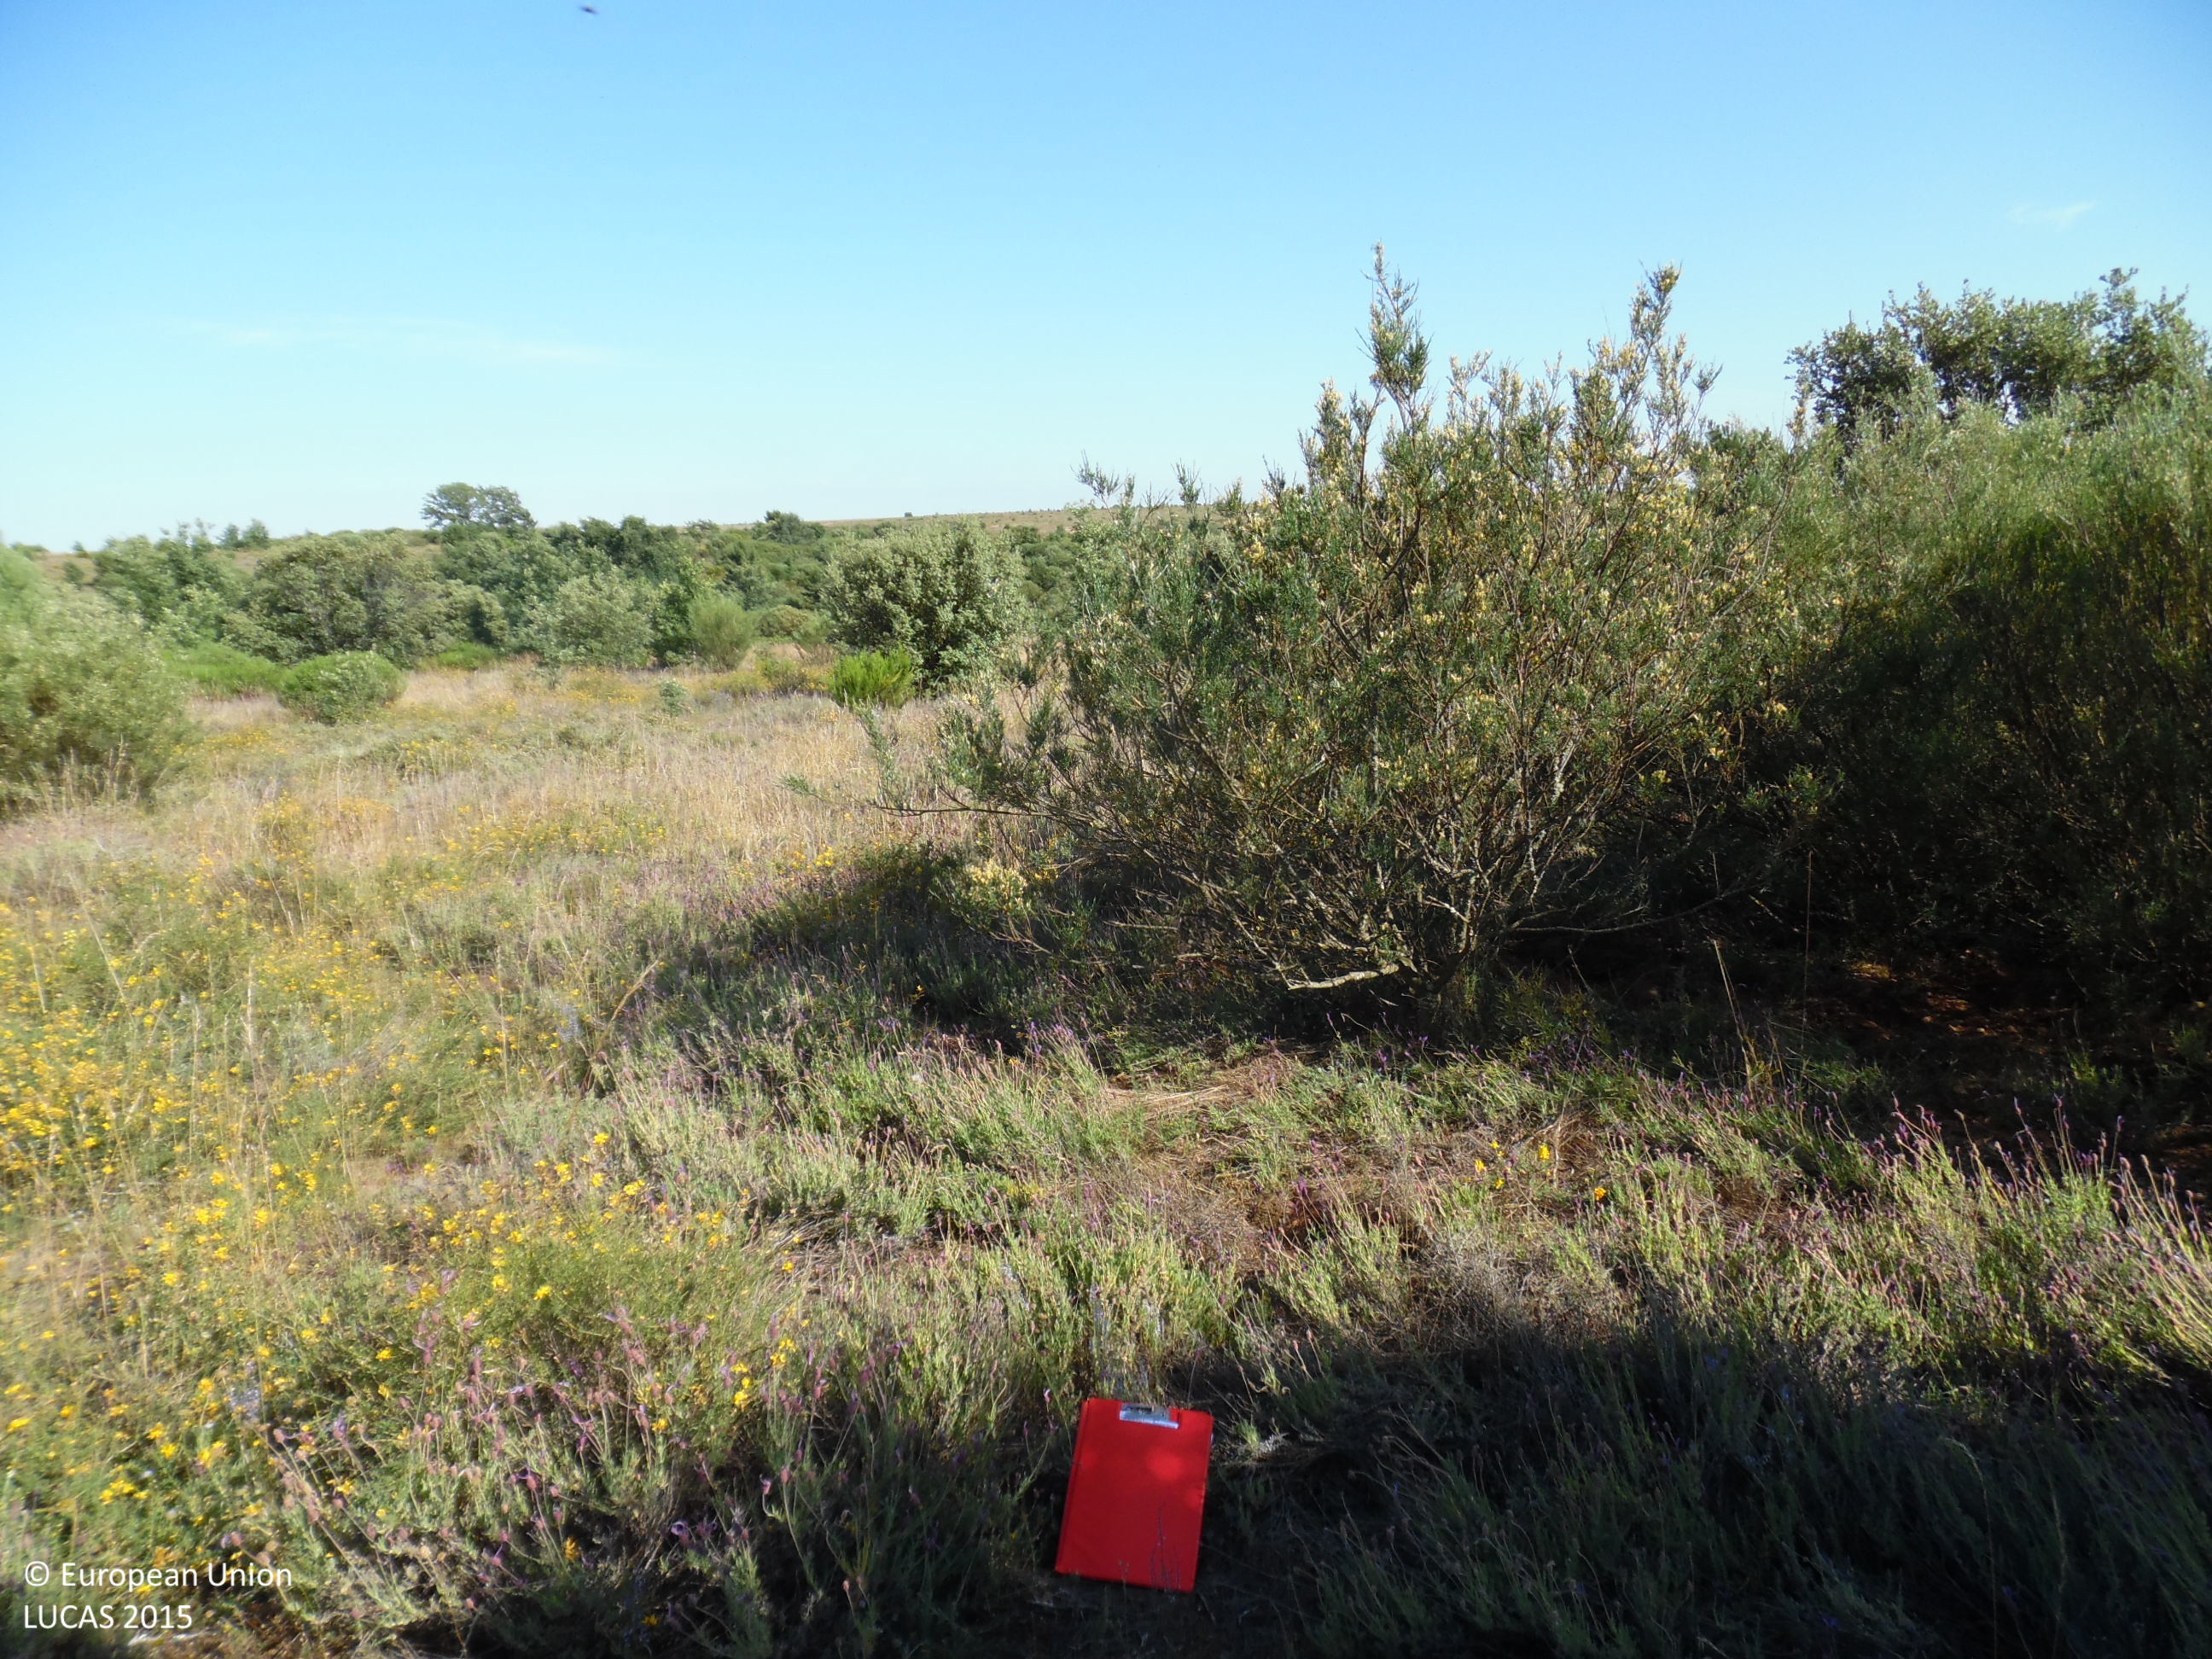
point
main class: Grassland
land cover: Grassland with sparse tree/shrub cover
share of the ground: > 75 %
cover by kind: herbaceous plants 95 %, broadleaved forest trees 5 %
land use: Abandoned areas
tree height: < 5 m
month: June
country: ES
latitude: 42.7136
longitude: -5.7684
